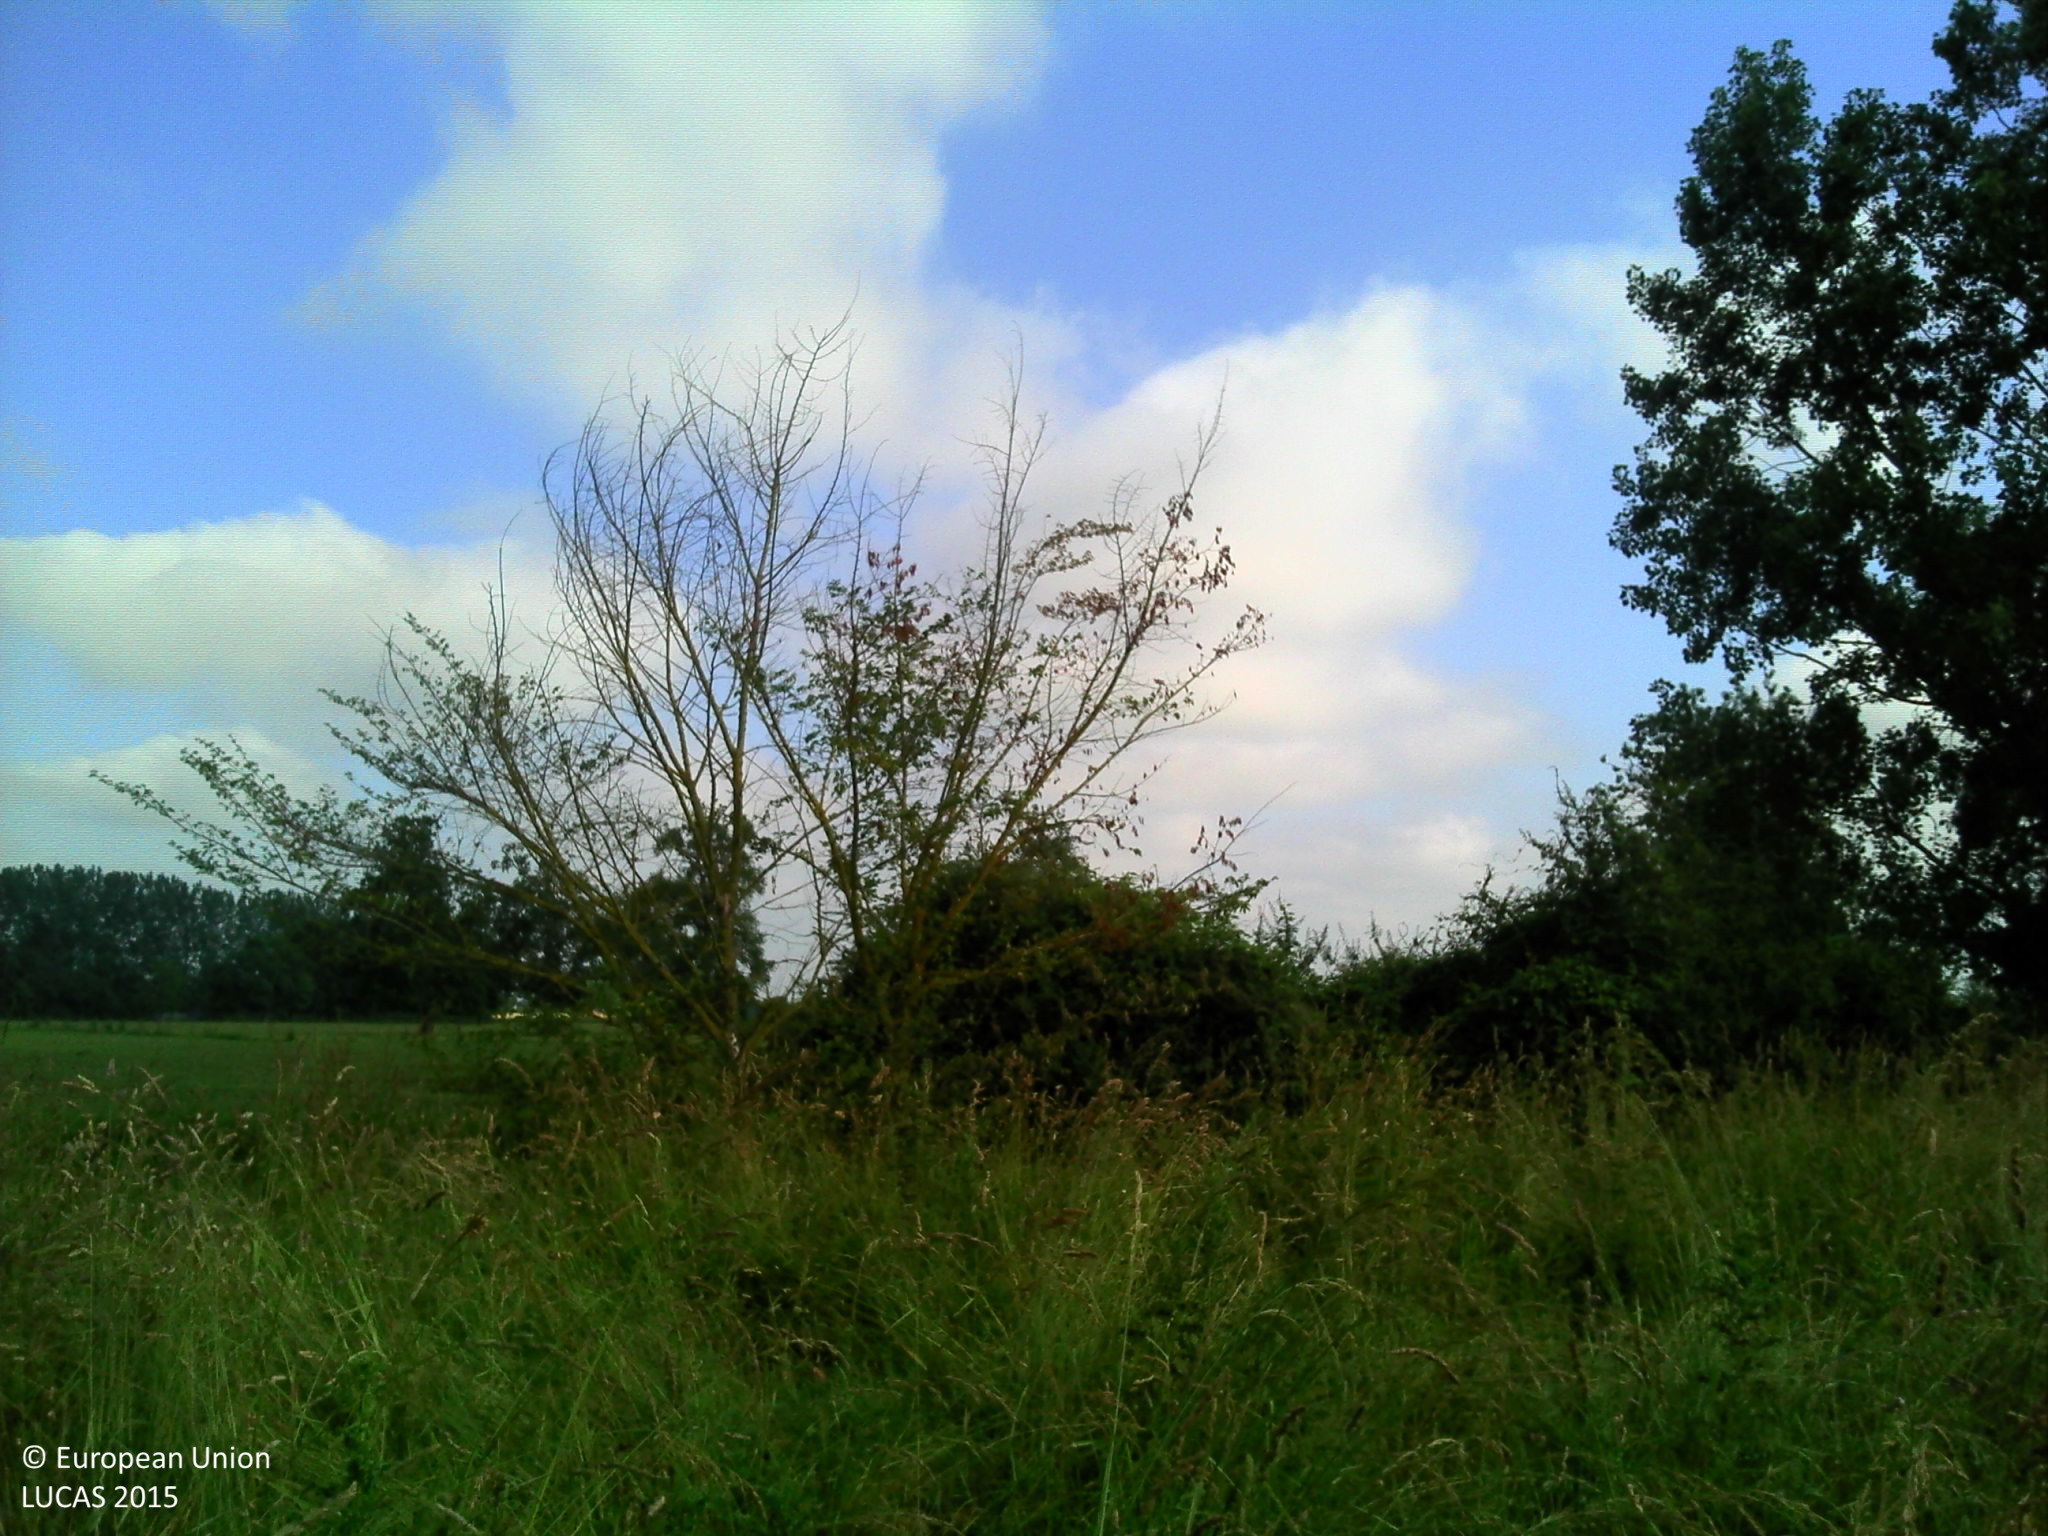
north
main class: Cropland
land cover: Maize
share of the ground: 25 - 50 %
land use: Agriculture (excluding fallow land and kitchen gardens)
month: June
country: FR
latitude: 48.1889
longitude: 0.2482
